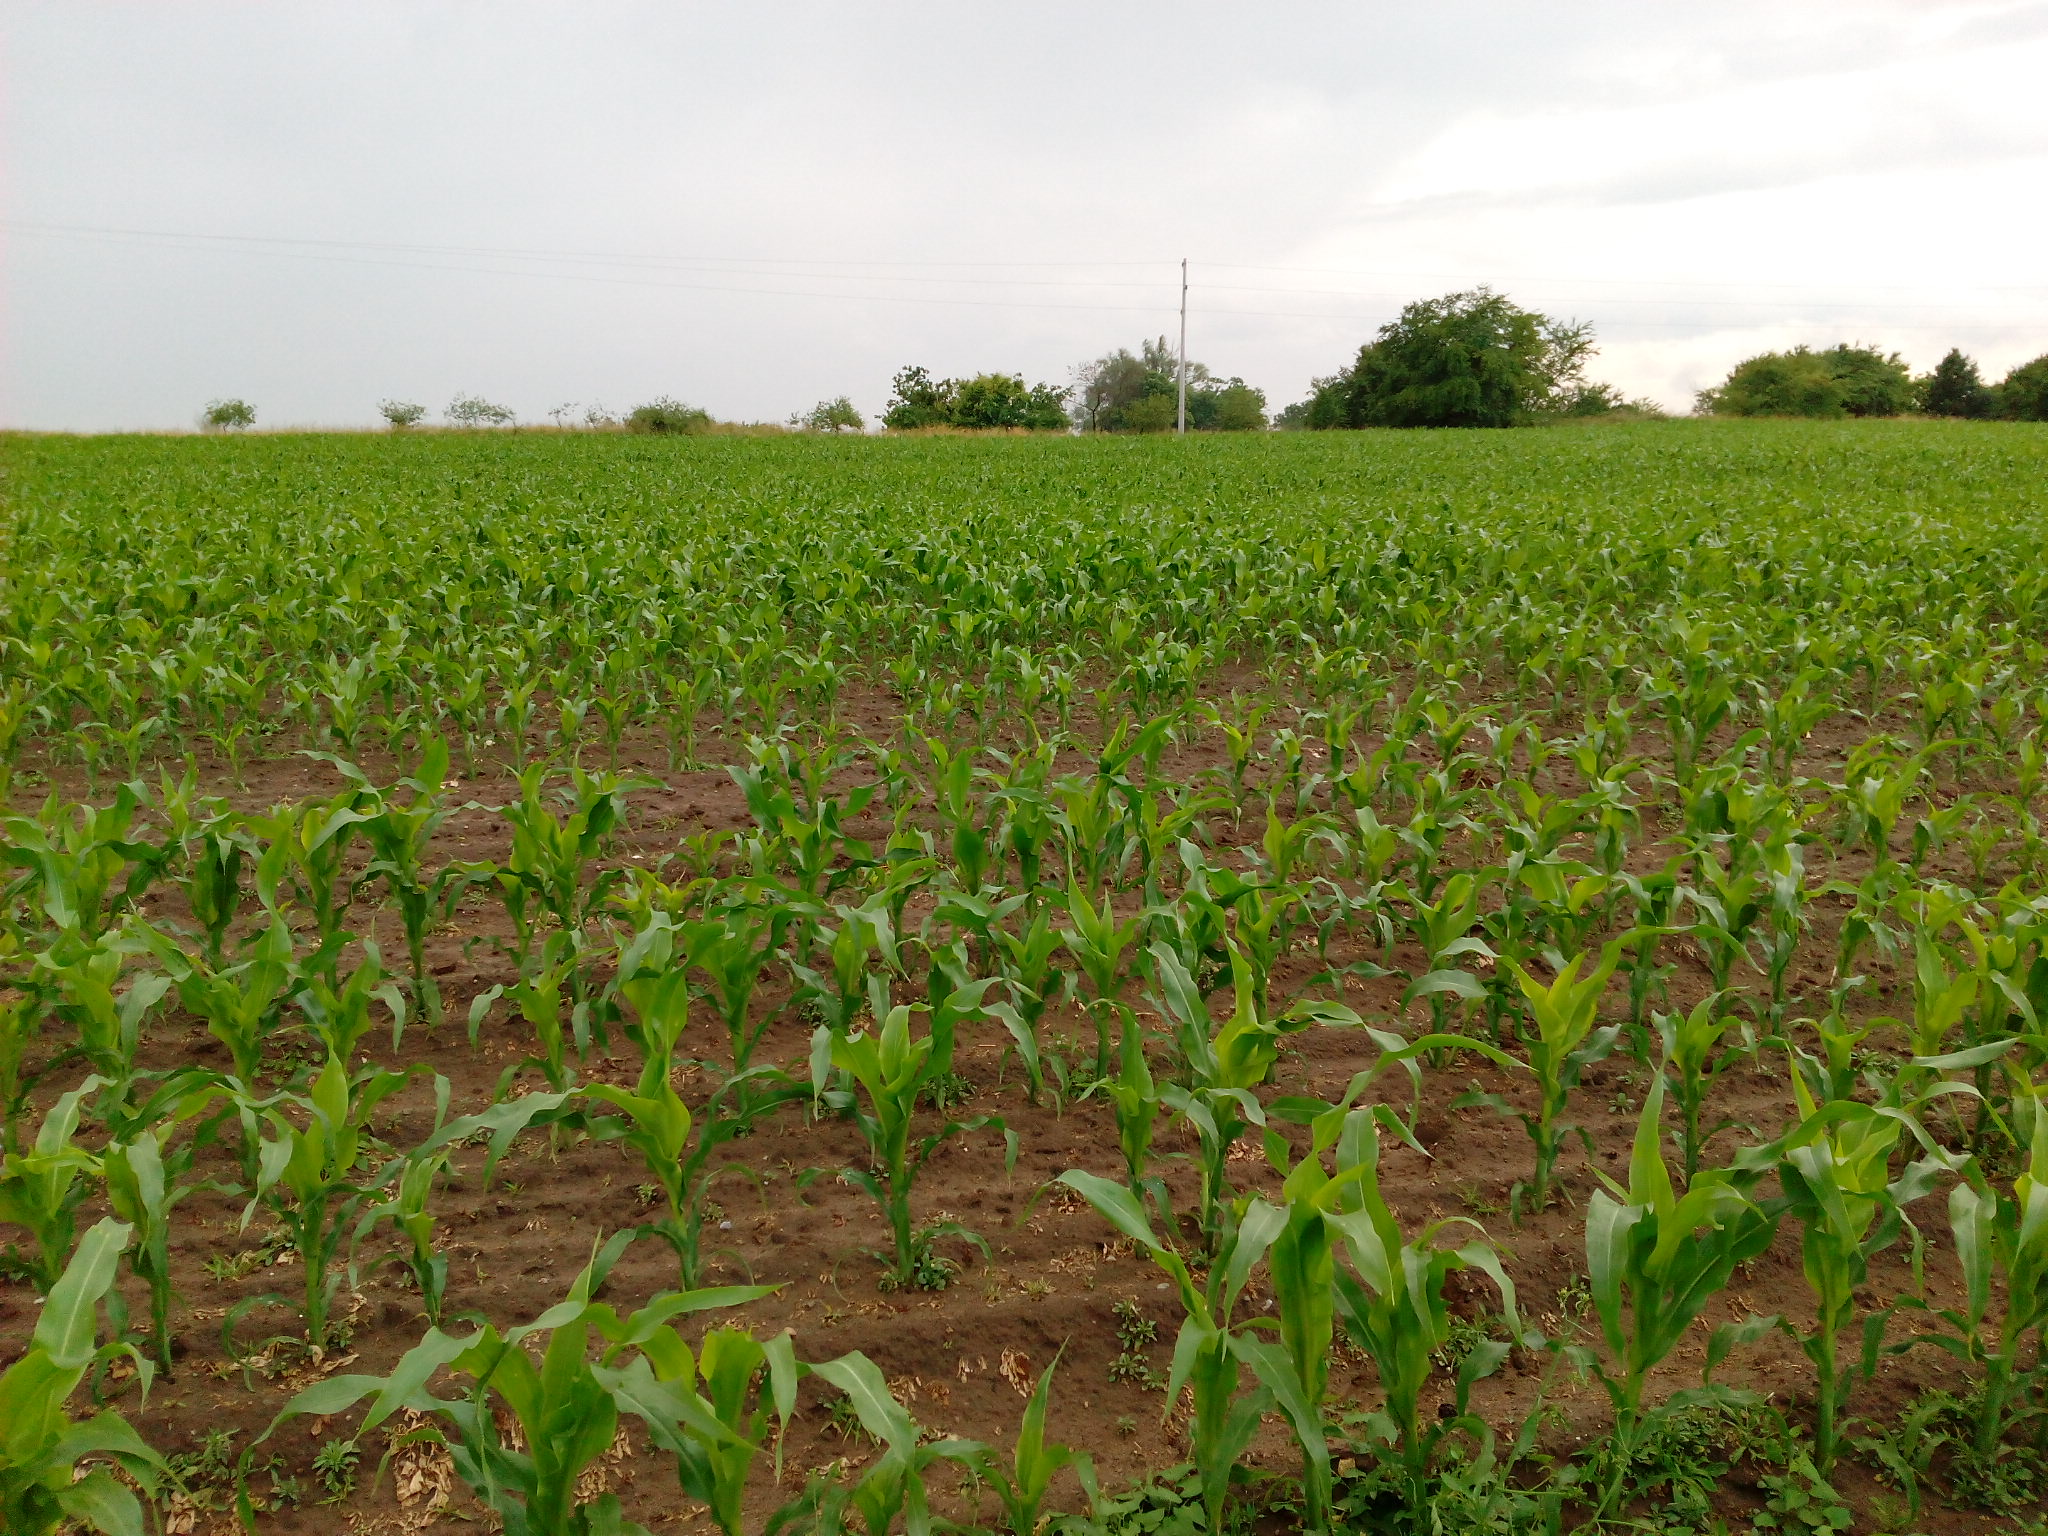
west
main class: Cropland
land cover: Maize
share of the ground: > 75 %
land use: Agriculture (excluding fallow land and kitchen gardens)
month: June
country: DE
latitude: 52.9468
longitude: 13.1697
